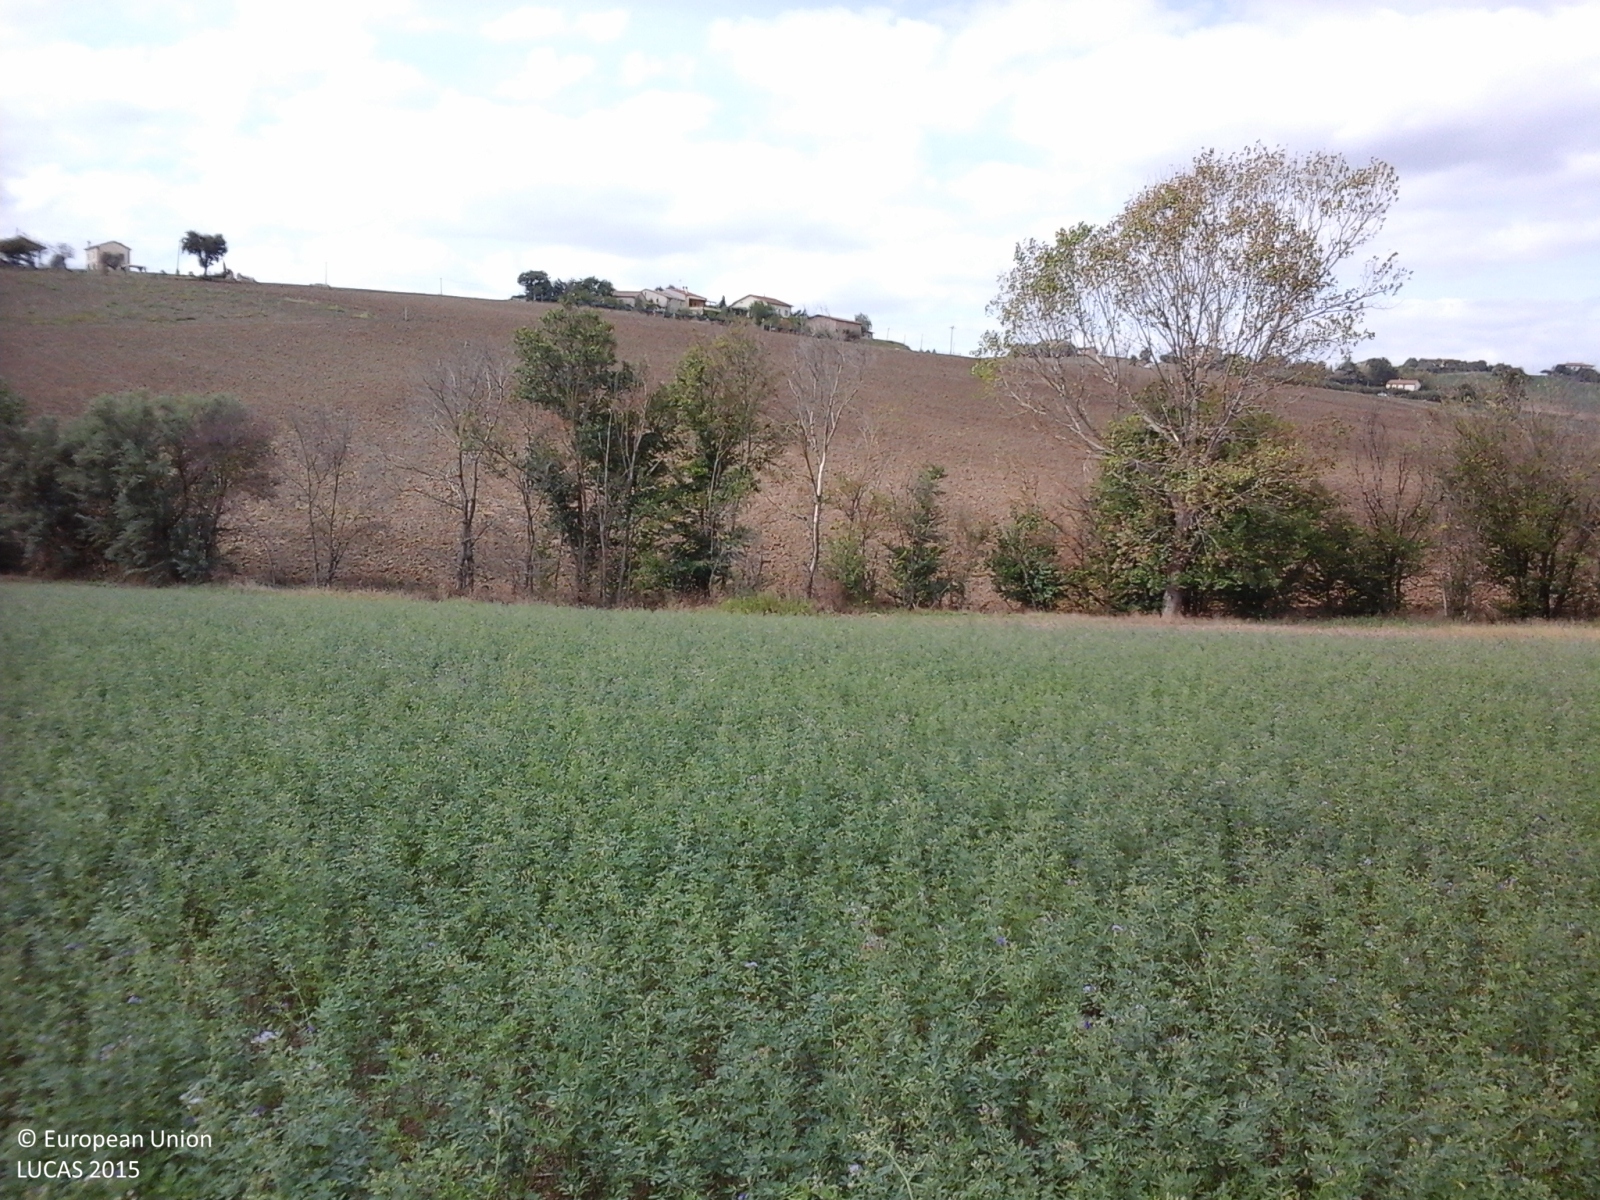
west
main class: Cropland
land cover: Lucerne
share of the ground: > 75 %
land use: Agriculture (excluding fallow land and kitchen gardens)
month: September
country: IT
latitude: 43.5663
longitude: 13.0258
